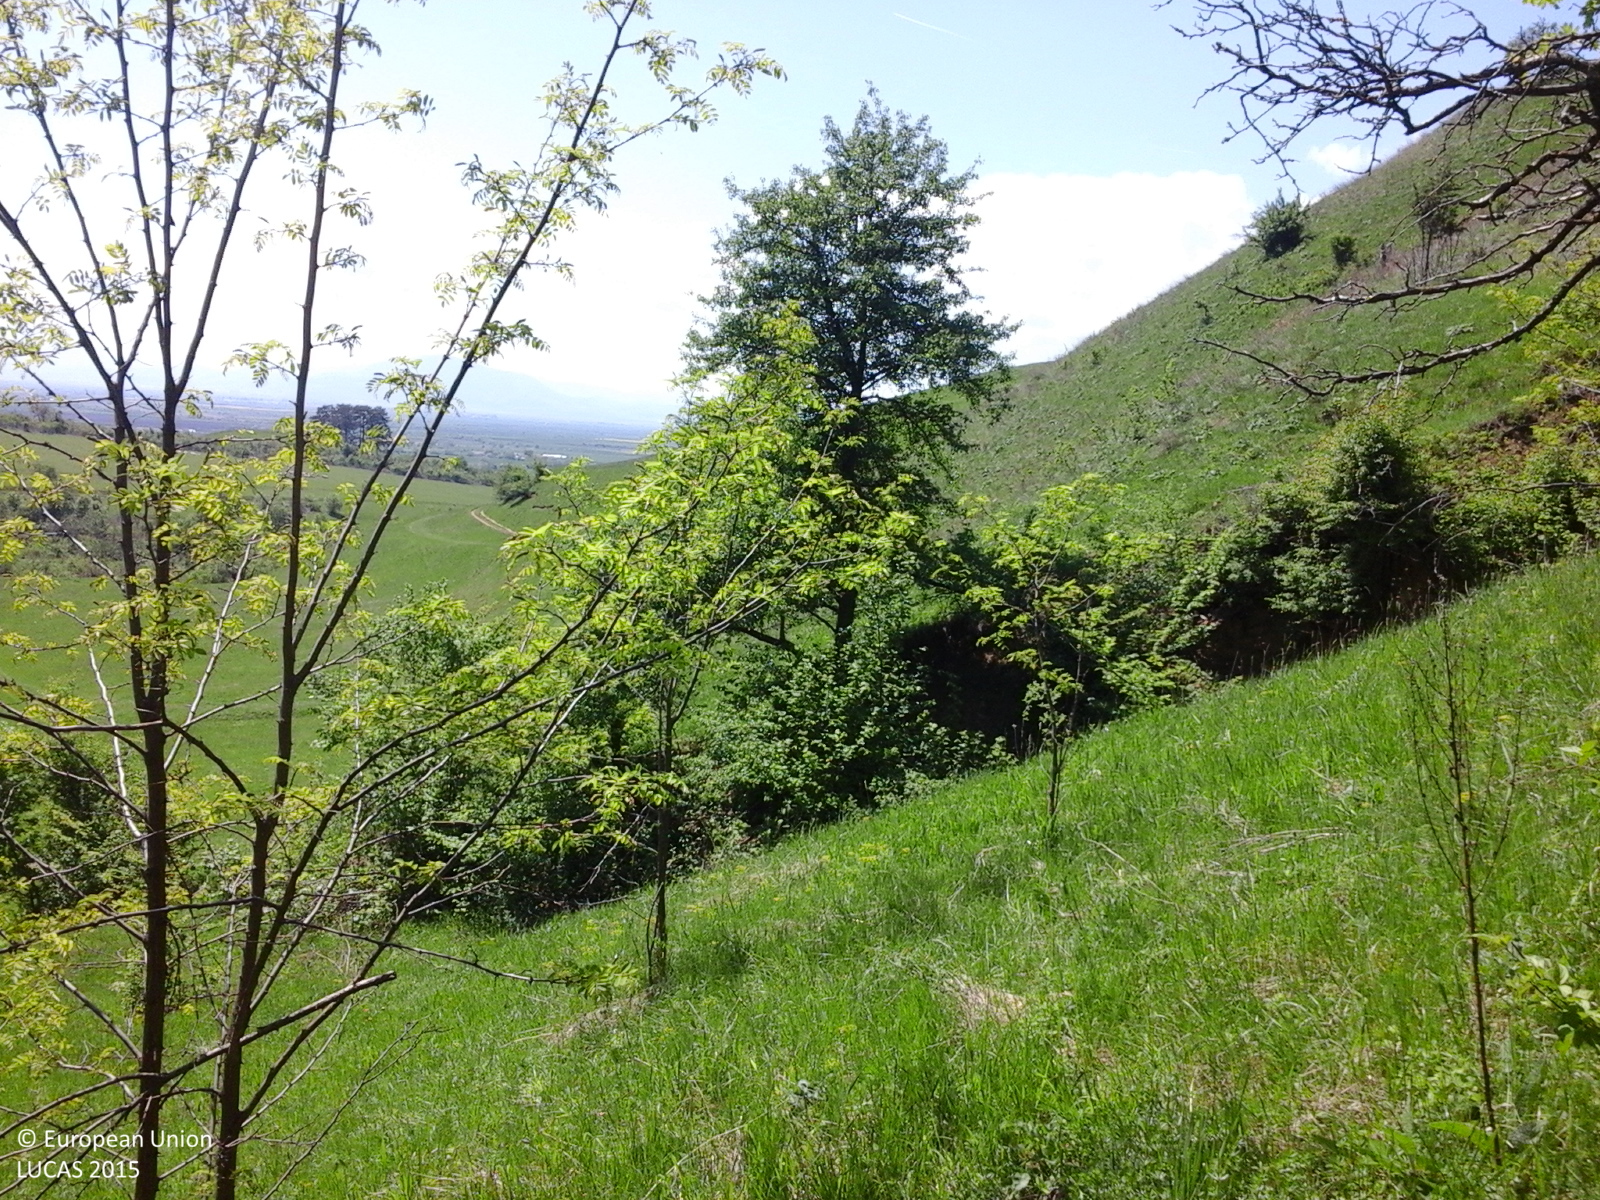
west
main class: Grassland
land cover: Grassland with sparse tree/shrub cover
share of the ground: > 75 %
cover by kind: herbaceous plants 85 %, shrubs 10 %, broadleaved forest trees 5 %
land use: Forestry
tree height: > 5 m
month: May
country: RO
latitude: 45.8112
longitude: 25.6657
